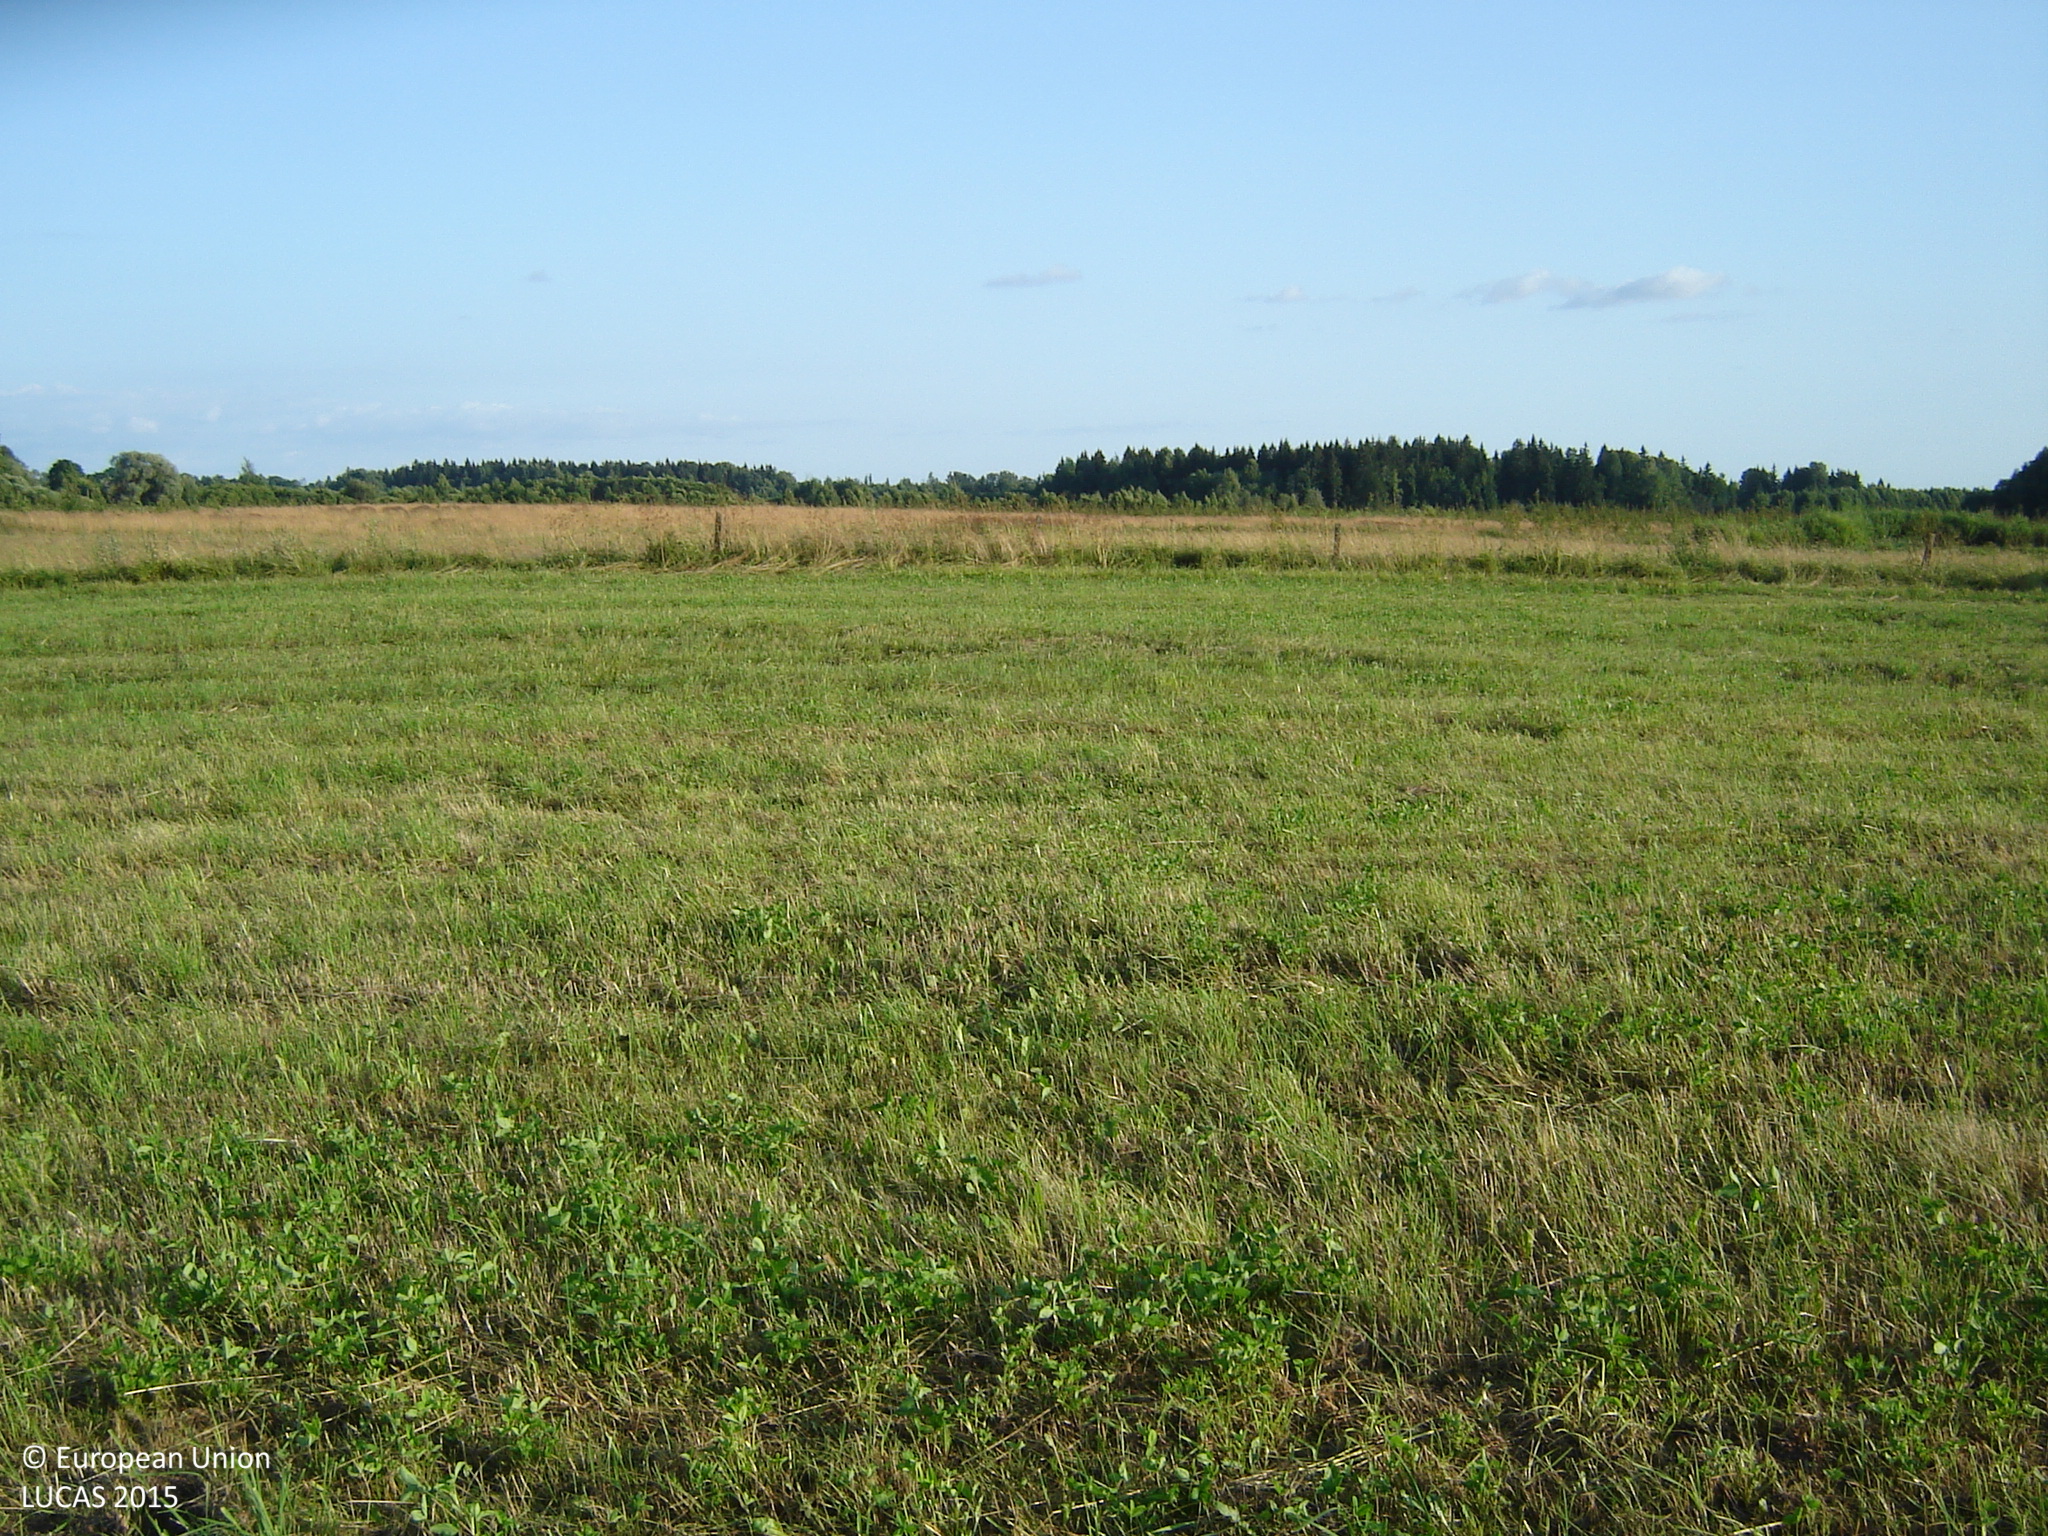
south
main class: Grassland
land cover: Grassland without tree/shrub cover
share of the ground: > 75 %
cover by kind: herbaceous plants 100 %
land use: Agriculture (excluding fallow land and kitchen gardens)
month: July
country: LT
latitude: 55.4706
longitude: 25.0947
